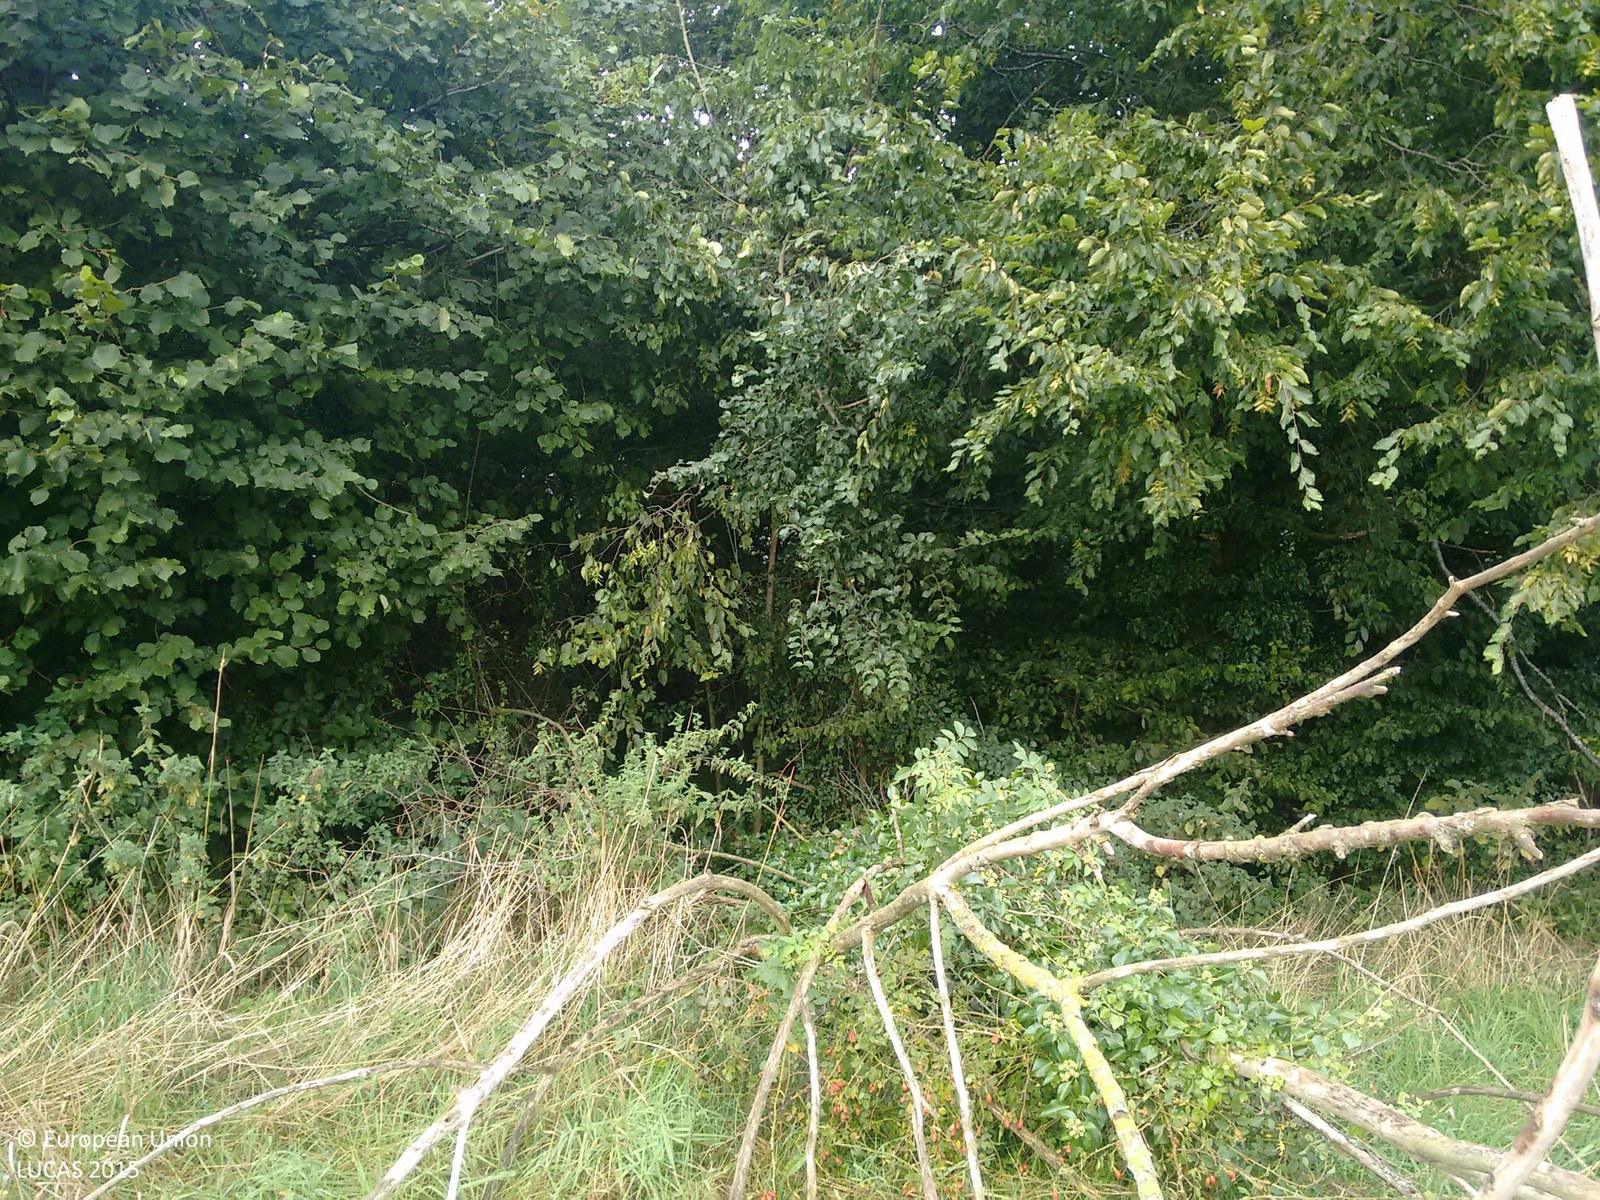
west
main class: Woodland
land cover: Broadleaved woodland
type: mesophytic deciduous forest
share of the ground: > 75 %
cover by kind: broadleaved forest trees 100 %
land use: Semi-natural and natural areas not in use
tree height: > 5 m
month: September
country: GB
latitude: 52.3001
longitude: 1.4015
